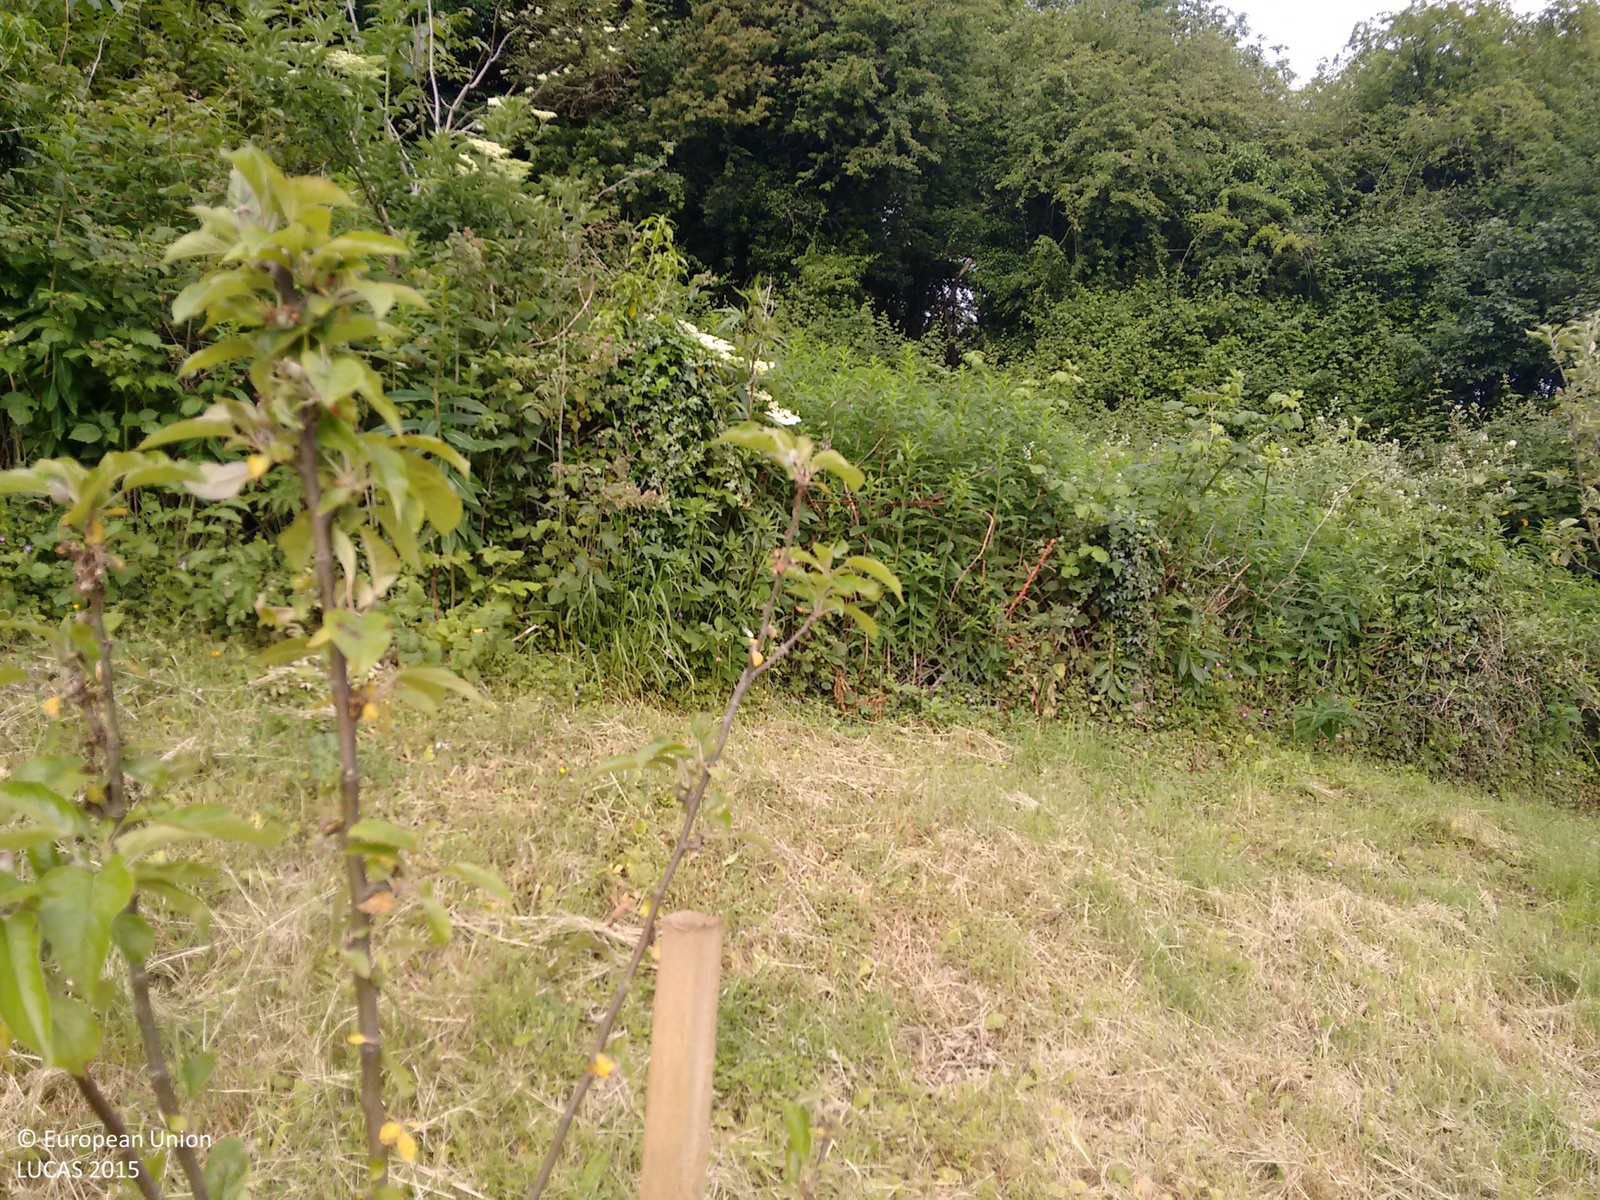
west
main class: Grassland
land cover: Grassland with sparse tree/shrub cover
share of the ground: > 75 %
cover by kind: herbaceous plants 95 %, broadleaved forest trees 5 %
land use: Residential
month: June
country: GB
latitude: 51.4106
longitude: -2.2690
